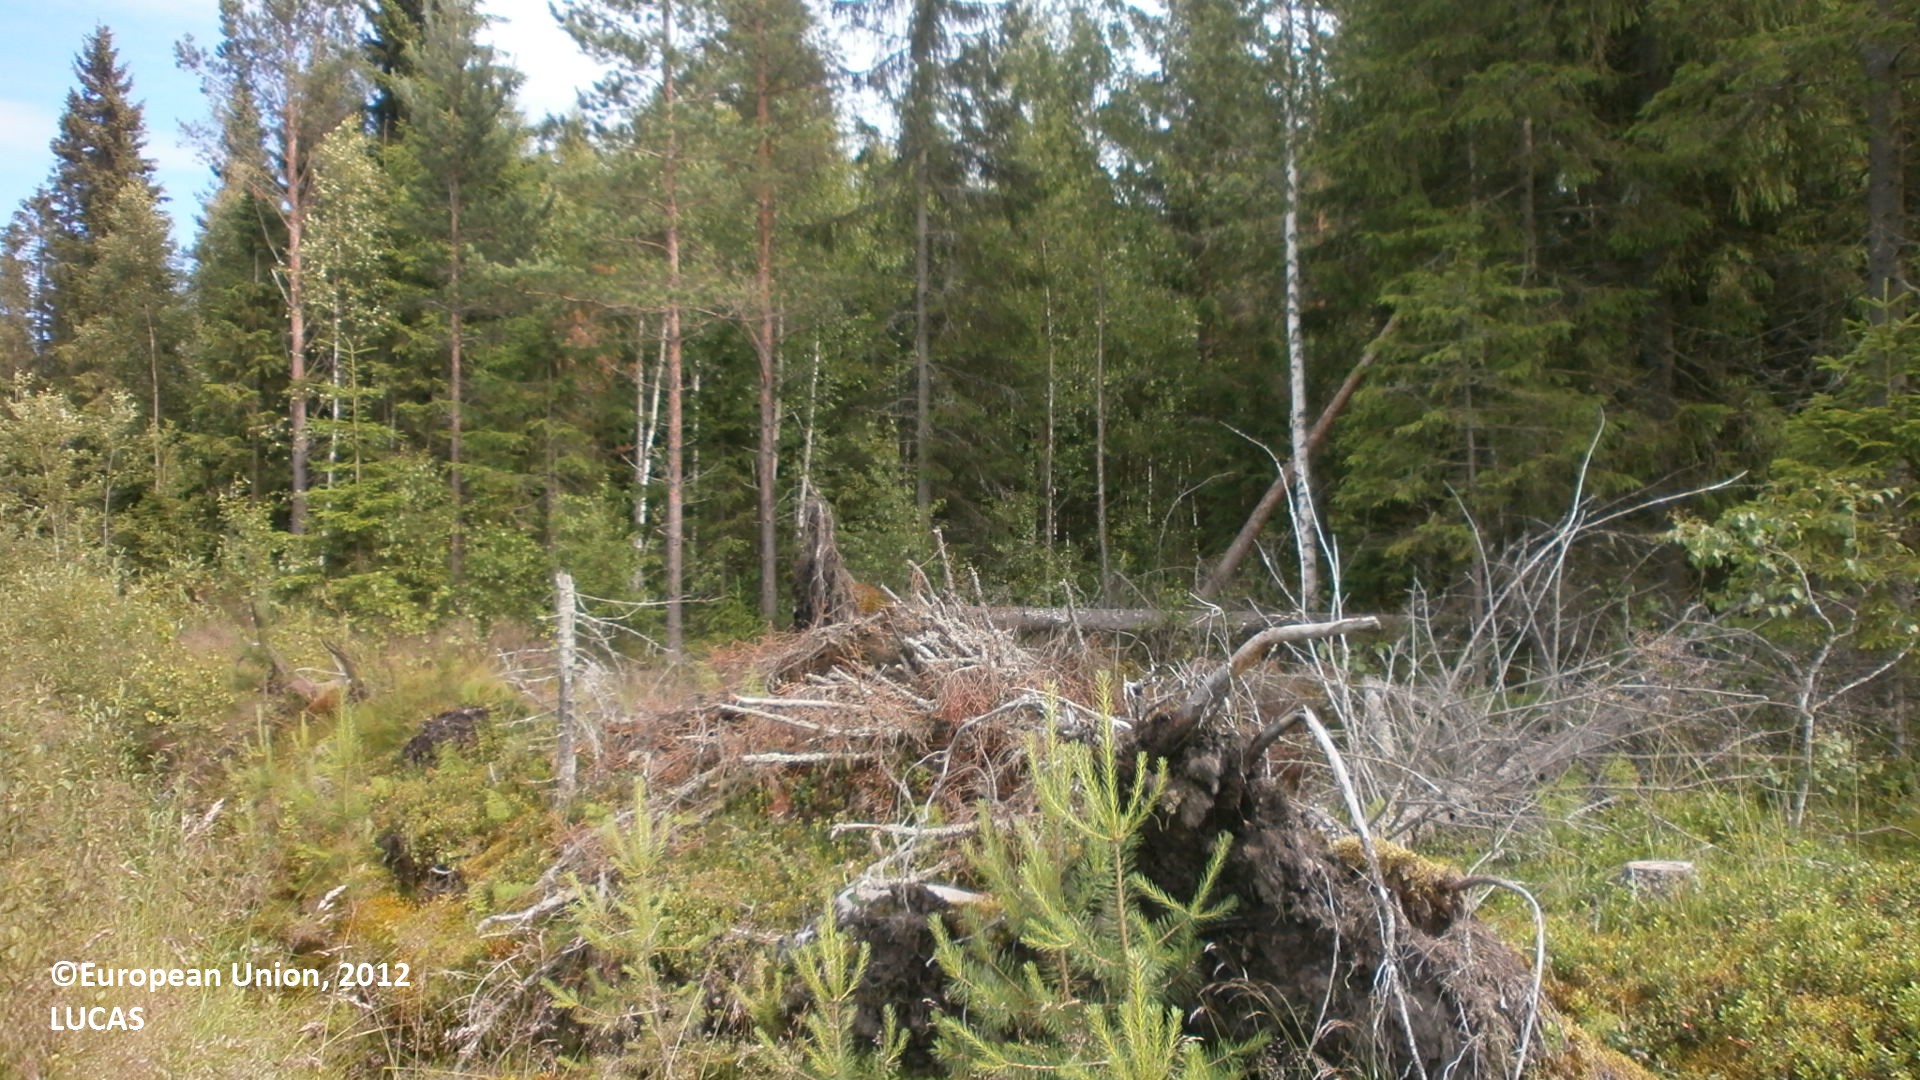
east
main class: Cropland
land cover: Barley
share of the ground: > 75 %
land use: Agriculture (excluding fallow land and kitchen gardens)
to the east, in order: Barley; Shruby margins; Ditches and canals; Shruby margins; Barley; Shruby margins; Abandoned hedges; Ditches and canals; Abandoned hedges; Shruby margins; Barley; Shruby margins; Ditches and canals; Spruce dominated coniferous woodland; Ditches and canals; Grassland with sparse tree/shrub cover; Ditches and canals; Grassland with sparse tree/shrub cover; Spruce dominated coniferous woodland
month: July
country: FI
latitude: 64.2249
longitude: 23.8915
